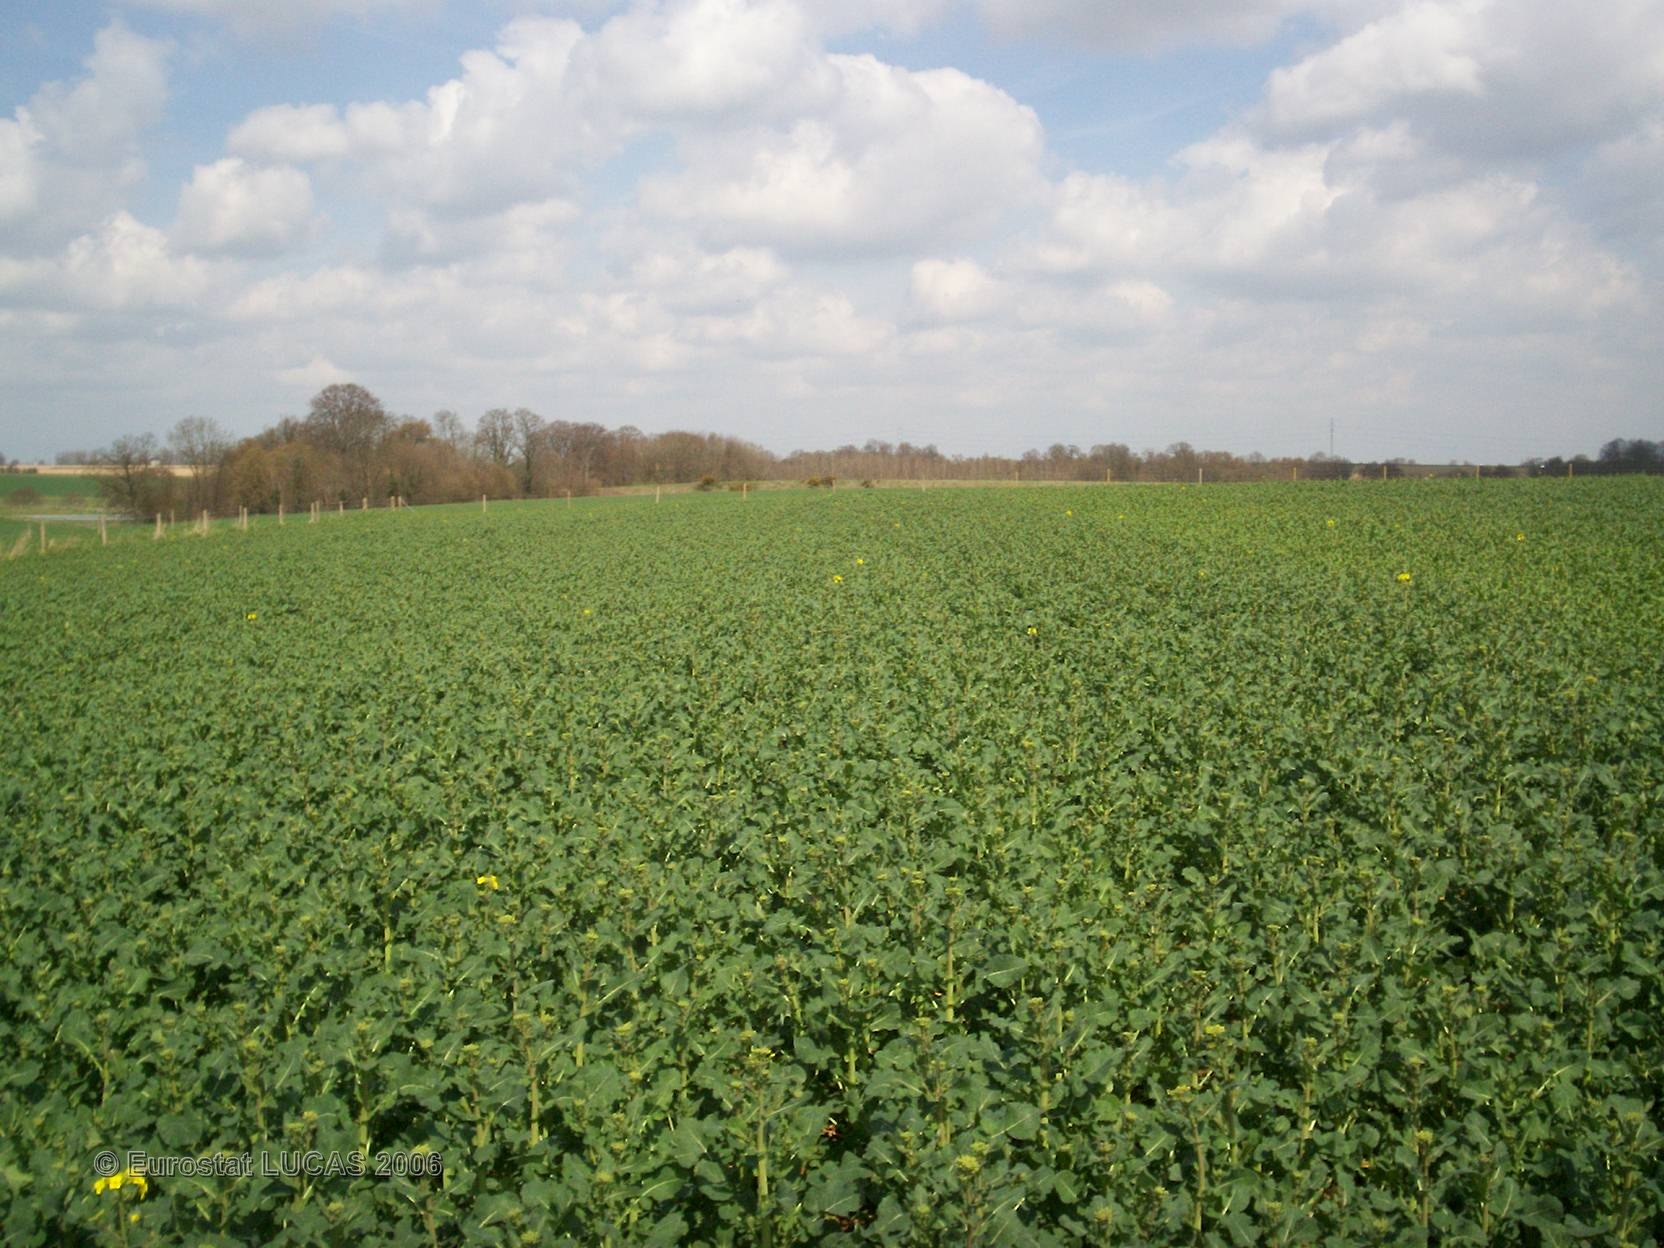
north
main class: Cropland
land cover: Rape and turnip rape
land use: Agriculture (excluding fallow land and kitchen gardens)
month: April
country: FR
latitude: 49.6593
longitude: 0.9308
